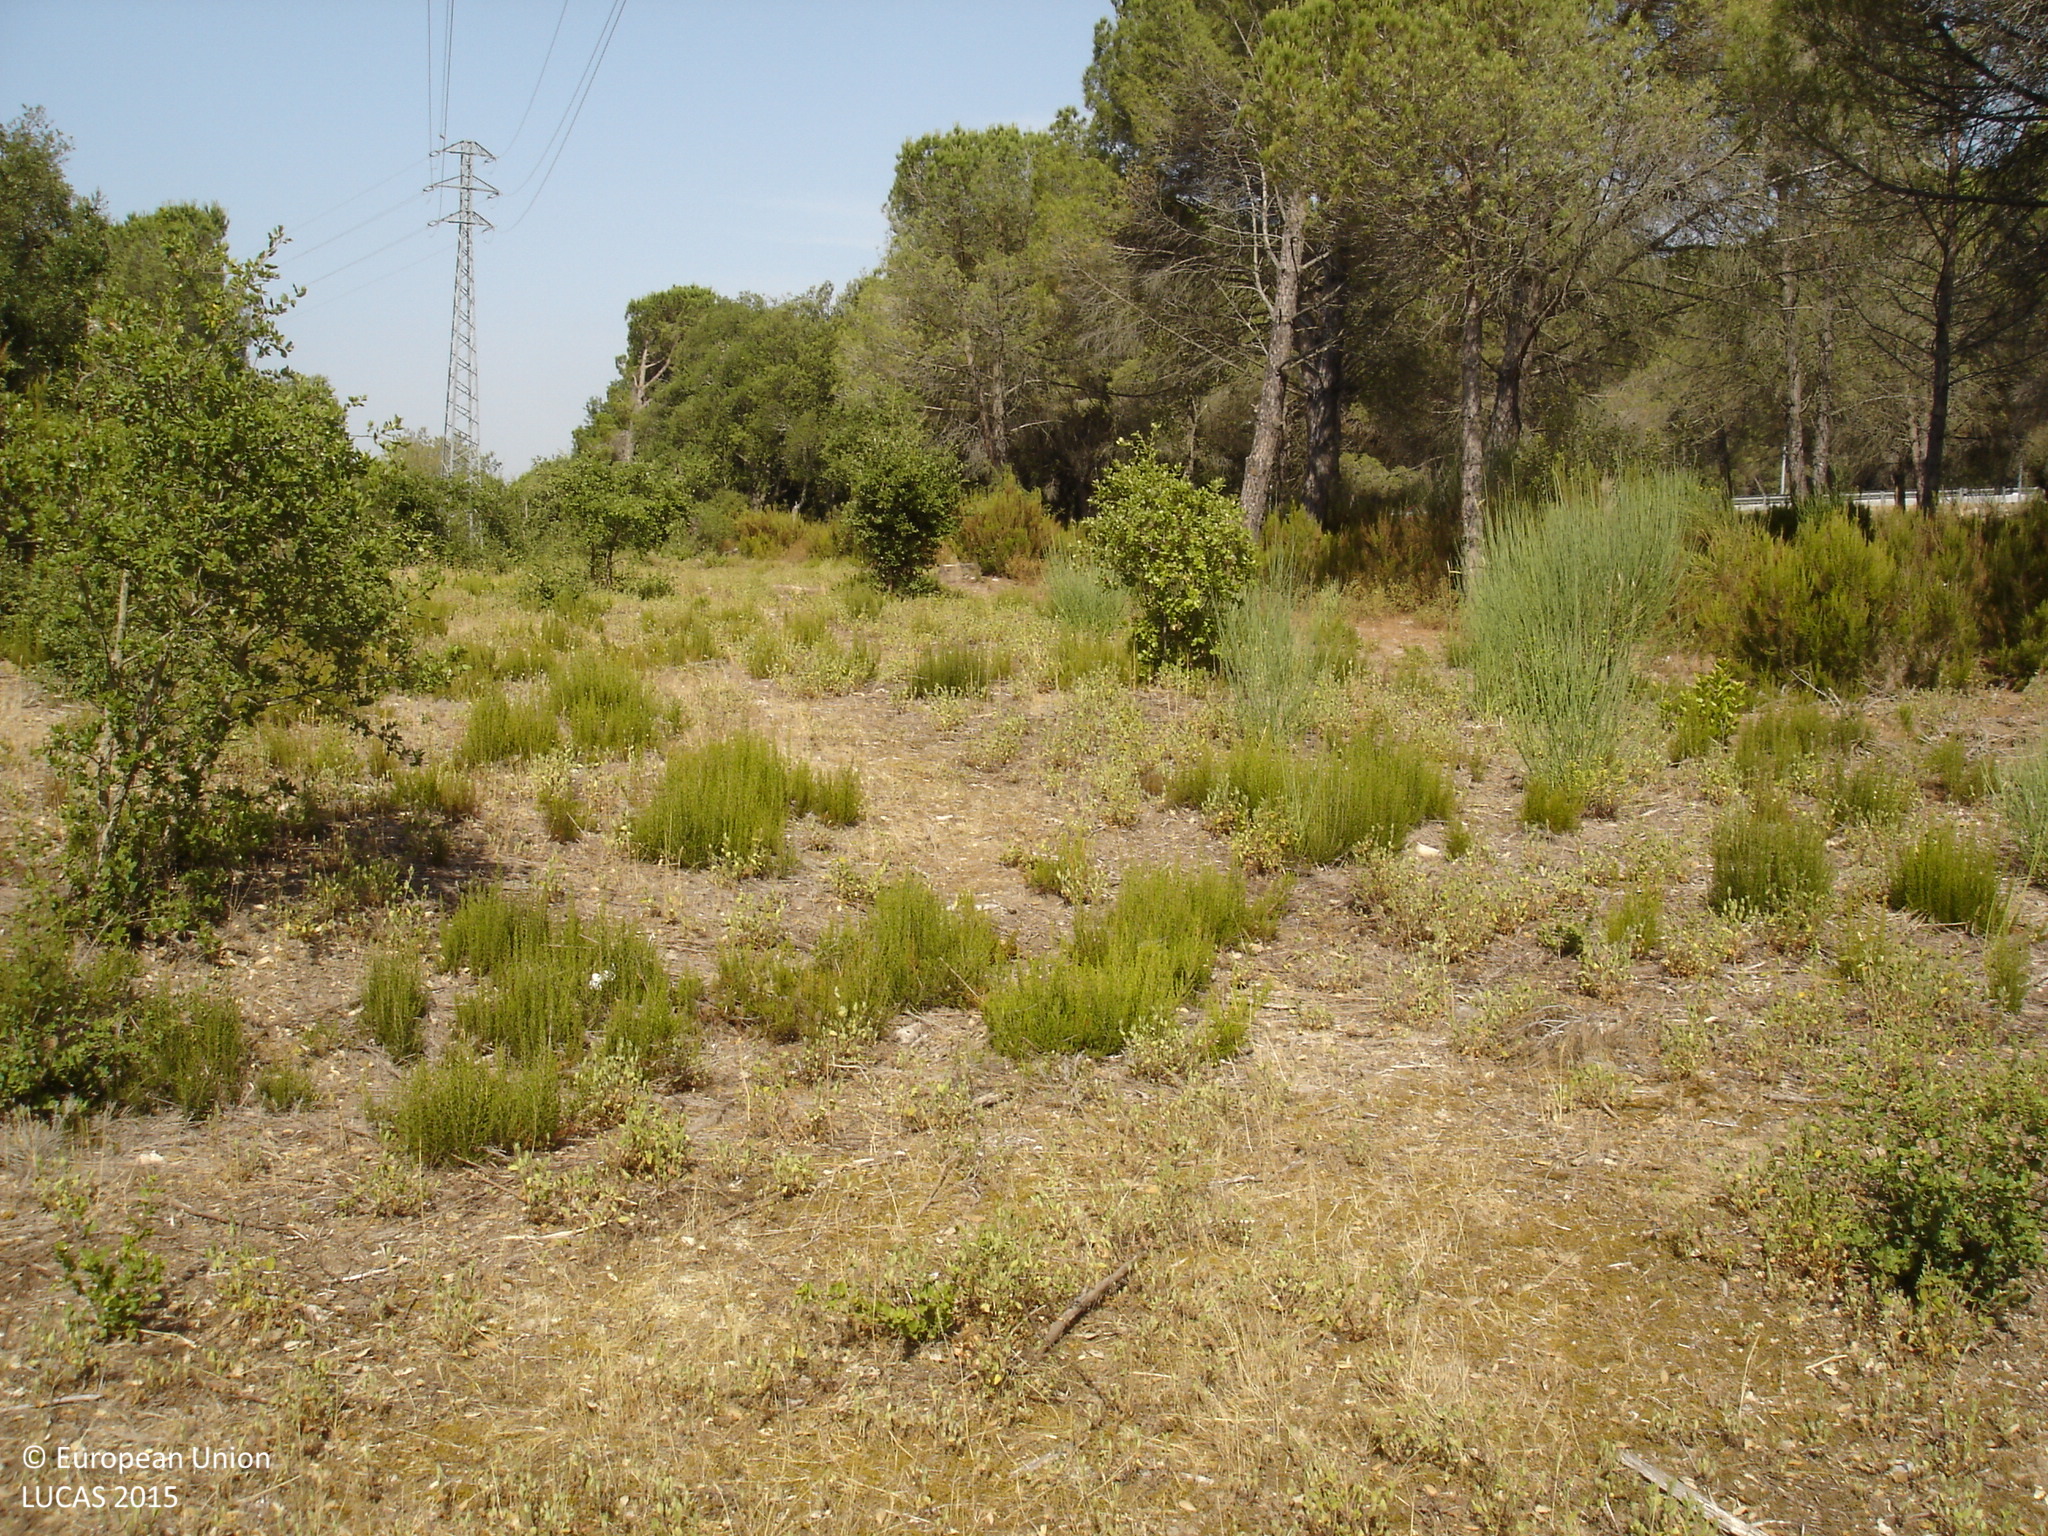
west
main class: Woodland
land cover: Other mixed woodland
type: thermophilous deciduous forest
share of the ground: 25 - 50 %
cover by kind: herbaceous plants 55 %, broadleaved forest trees 30 %, coniferous forest trees 15 %
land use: Forestry
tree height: > 5 m
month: July
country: ES
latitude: 41.8167
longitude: 3.0465
